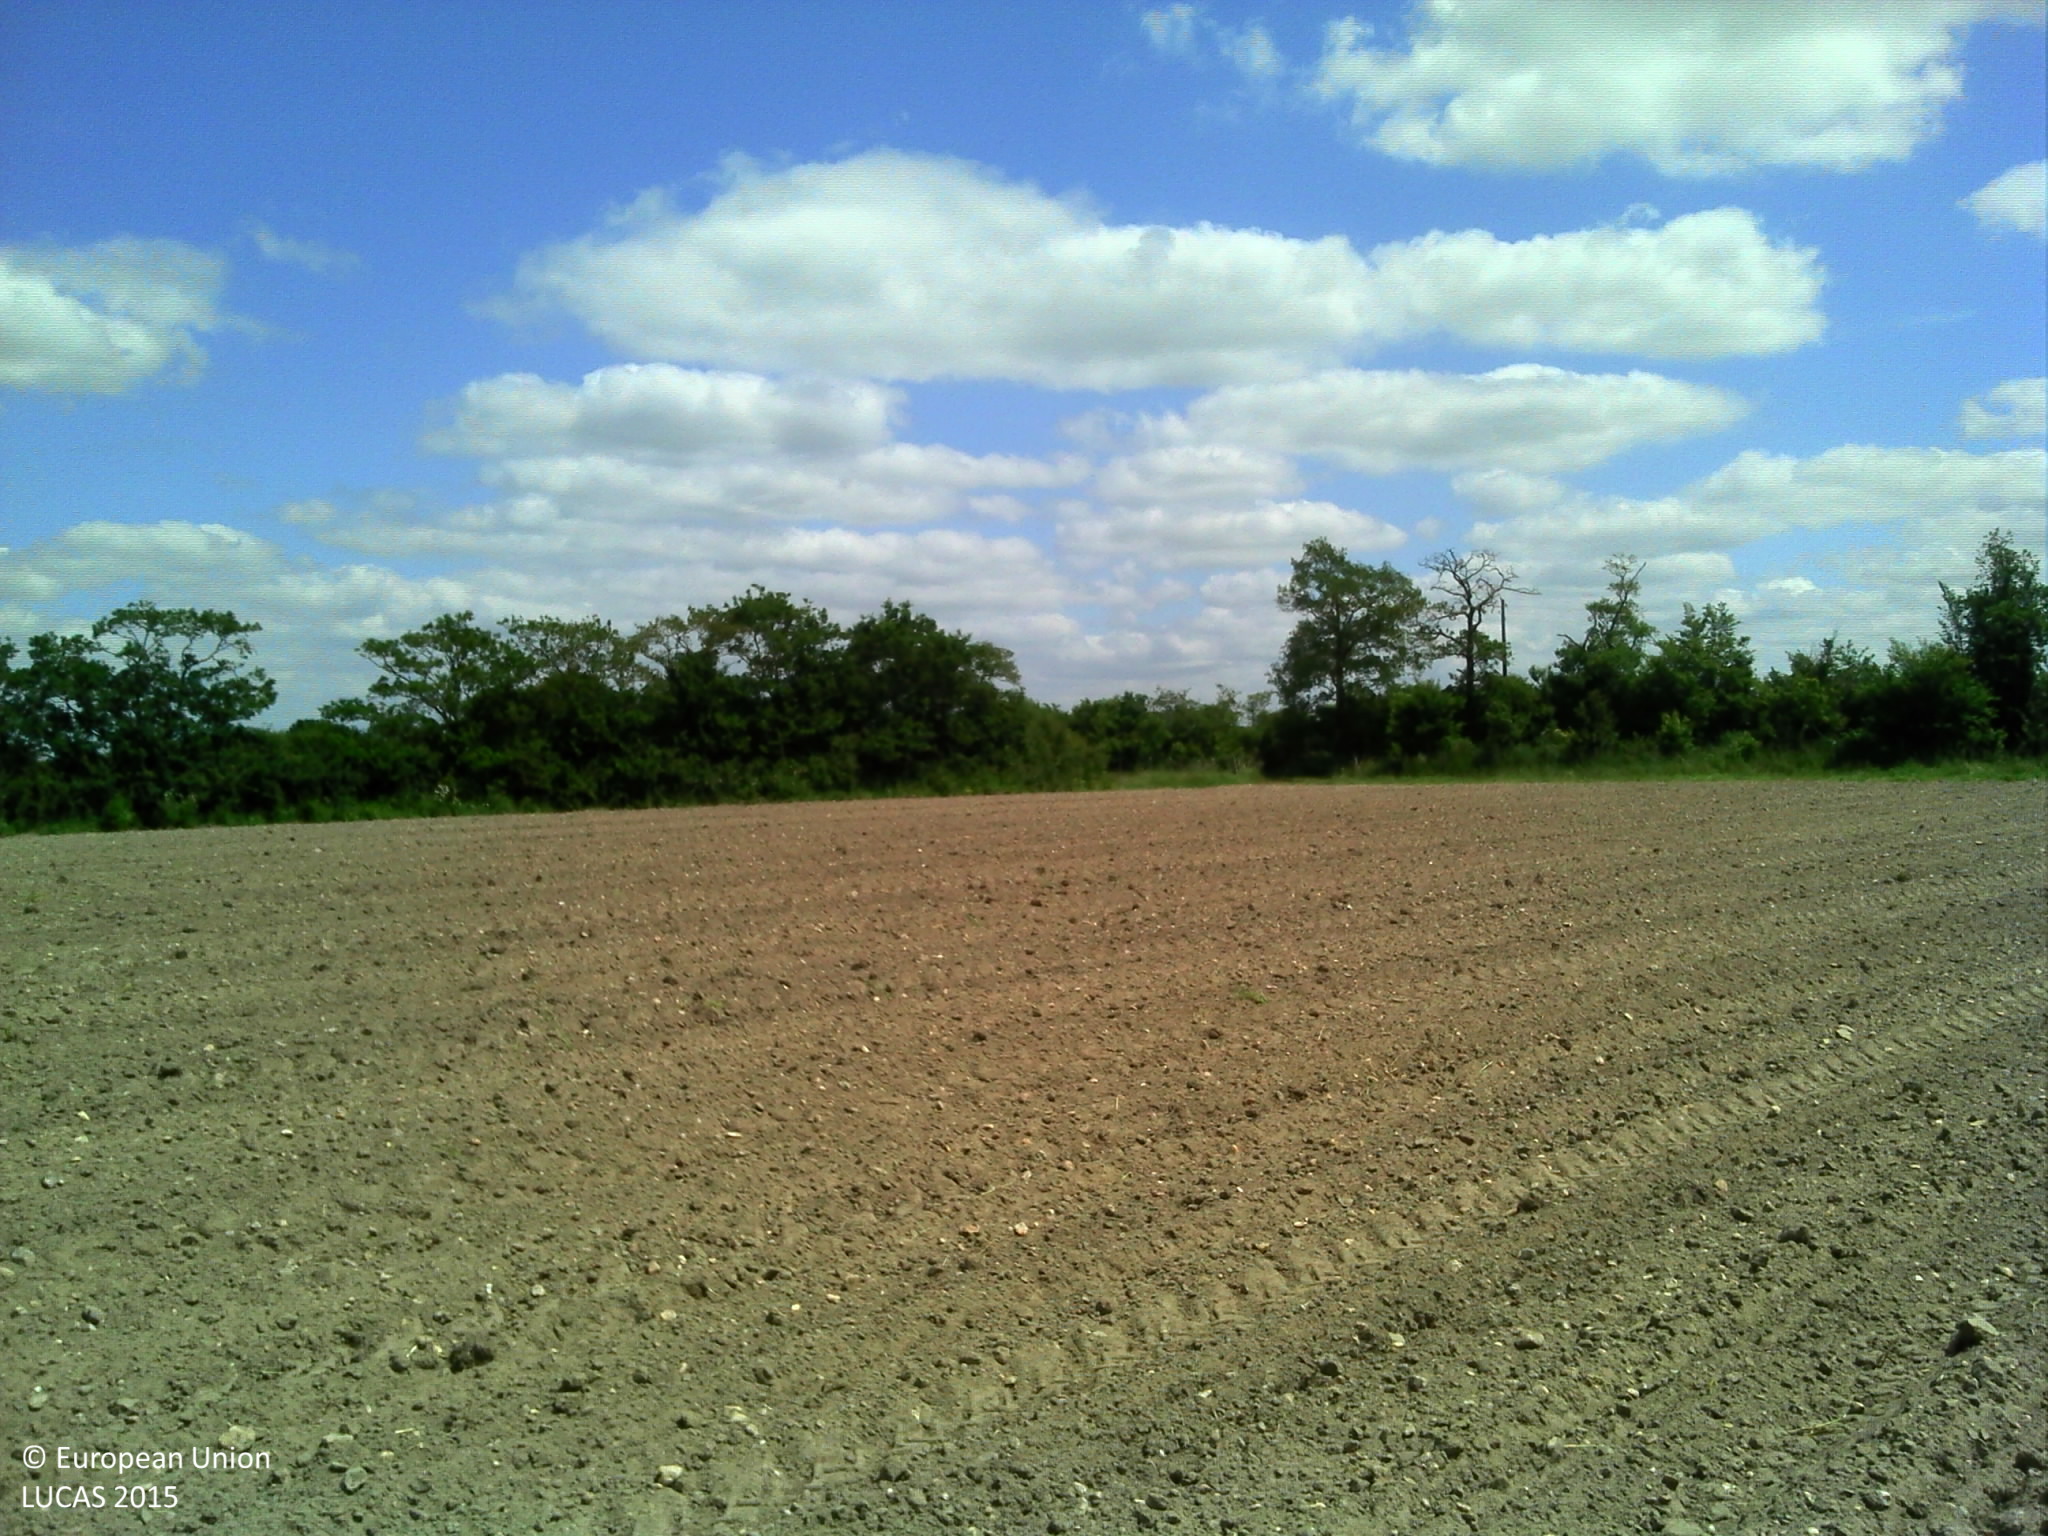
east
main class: Cropland
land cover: Maize
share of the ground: < 10 %
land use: Agriculture (excluding fallow land and kitchen gardens)
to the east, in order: Maize; Managed hedges; Grass margins; Maize; Fences; Managed hedges; Tracks; Grass margins; Ditches and canals; Lines of trees; Ditches and canals; Grass margins; Paved roads, cycling and walking lanes; Grass margins; Ditches and canals; Electric lines; Abandoned hedges; Grassland without tree/shrub cover; Oats
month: June
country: FR
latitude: 46.9212
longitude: -1.9033
